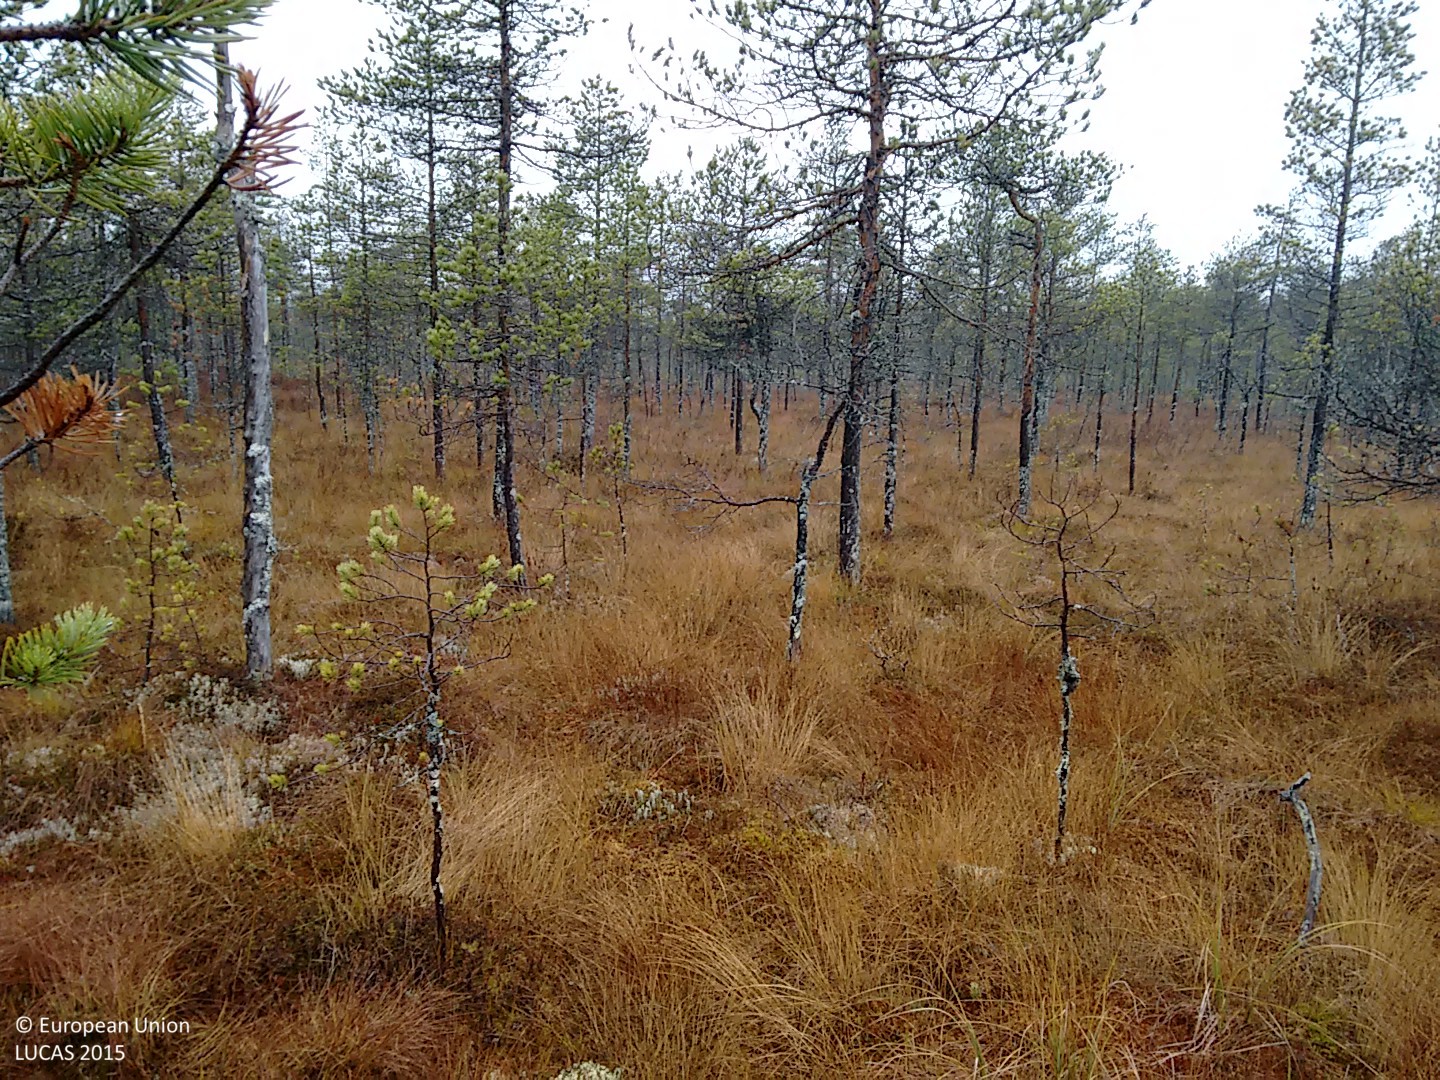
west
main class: Woodland
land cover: Pine dominated coniferous woodland
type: mire and swamp forests
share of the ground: 50 - 75 %
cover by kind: coniferous forest trees 55 %, shrubs 20 %, herbaceous plants 20 %, lichens and mosses 5 %
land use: Semi-natural and natural areas not in use
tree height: < 5 m
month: October
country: FI
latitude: 64.5382
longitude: 24.8992
